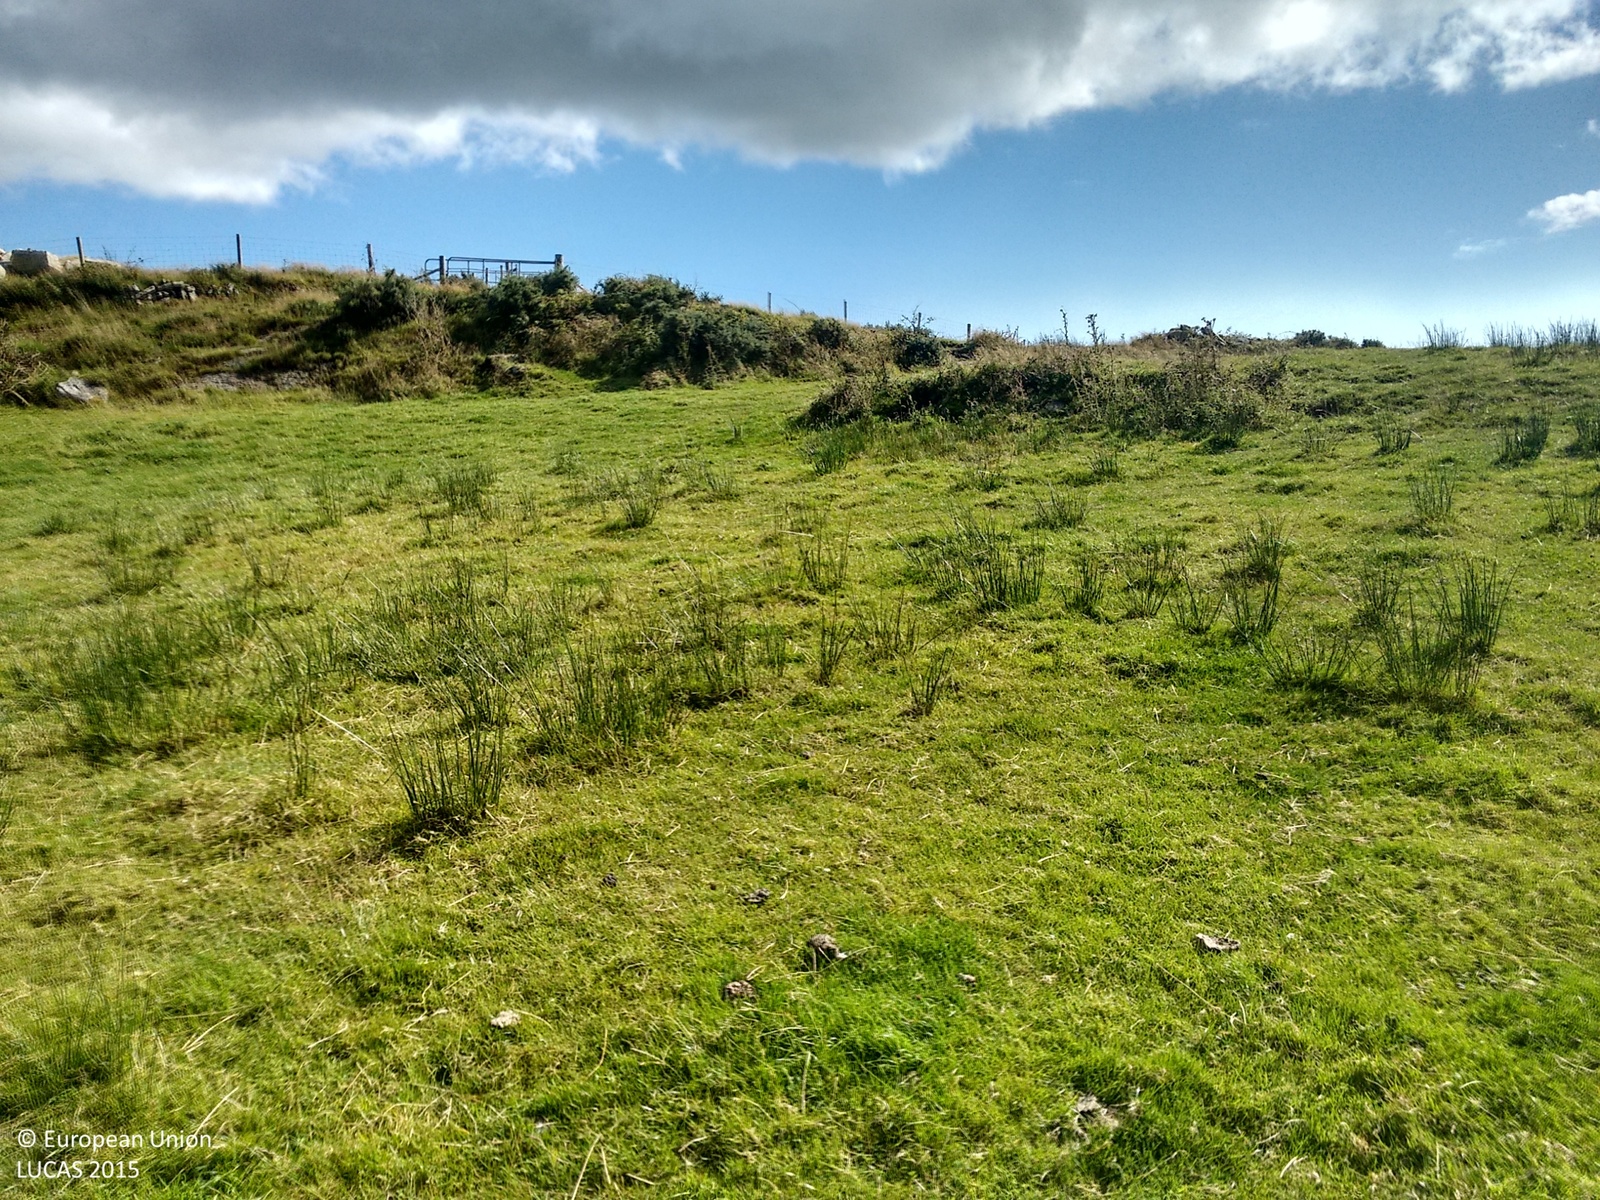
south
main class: Grassland
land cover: Grassland without tree/shrub cover
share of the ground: > 75 %
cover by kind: herbaceous plants 100 %
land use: Agriculture (excluding fallow land and kitchen gardens)
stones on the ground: < 10 %
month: August
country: IE
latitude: 51.7186
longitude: -9.4990
